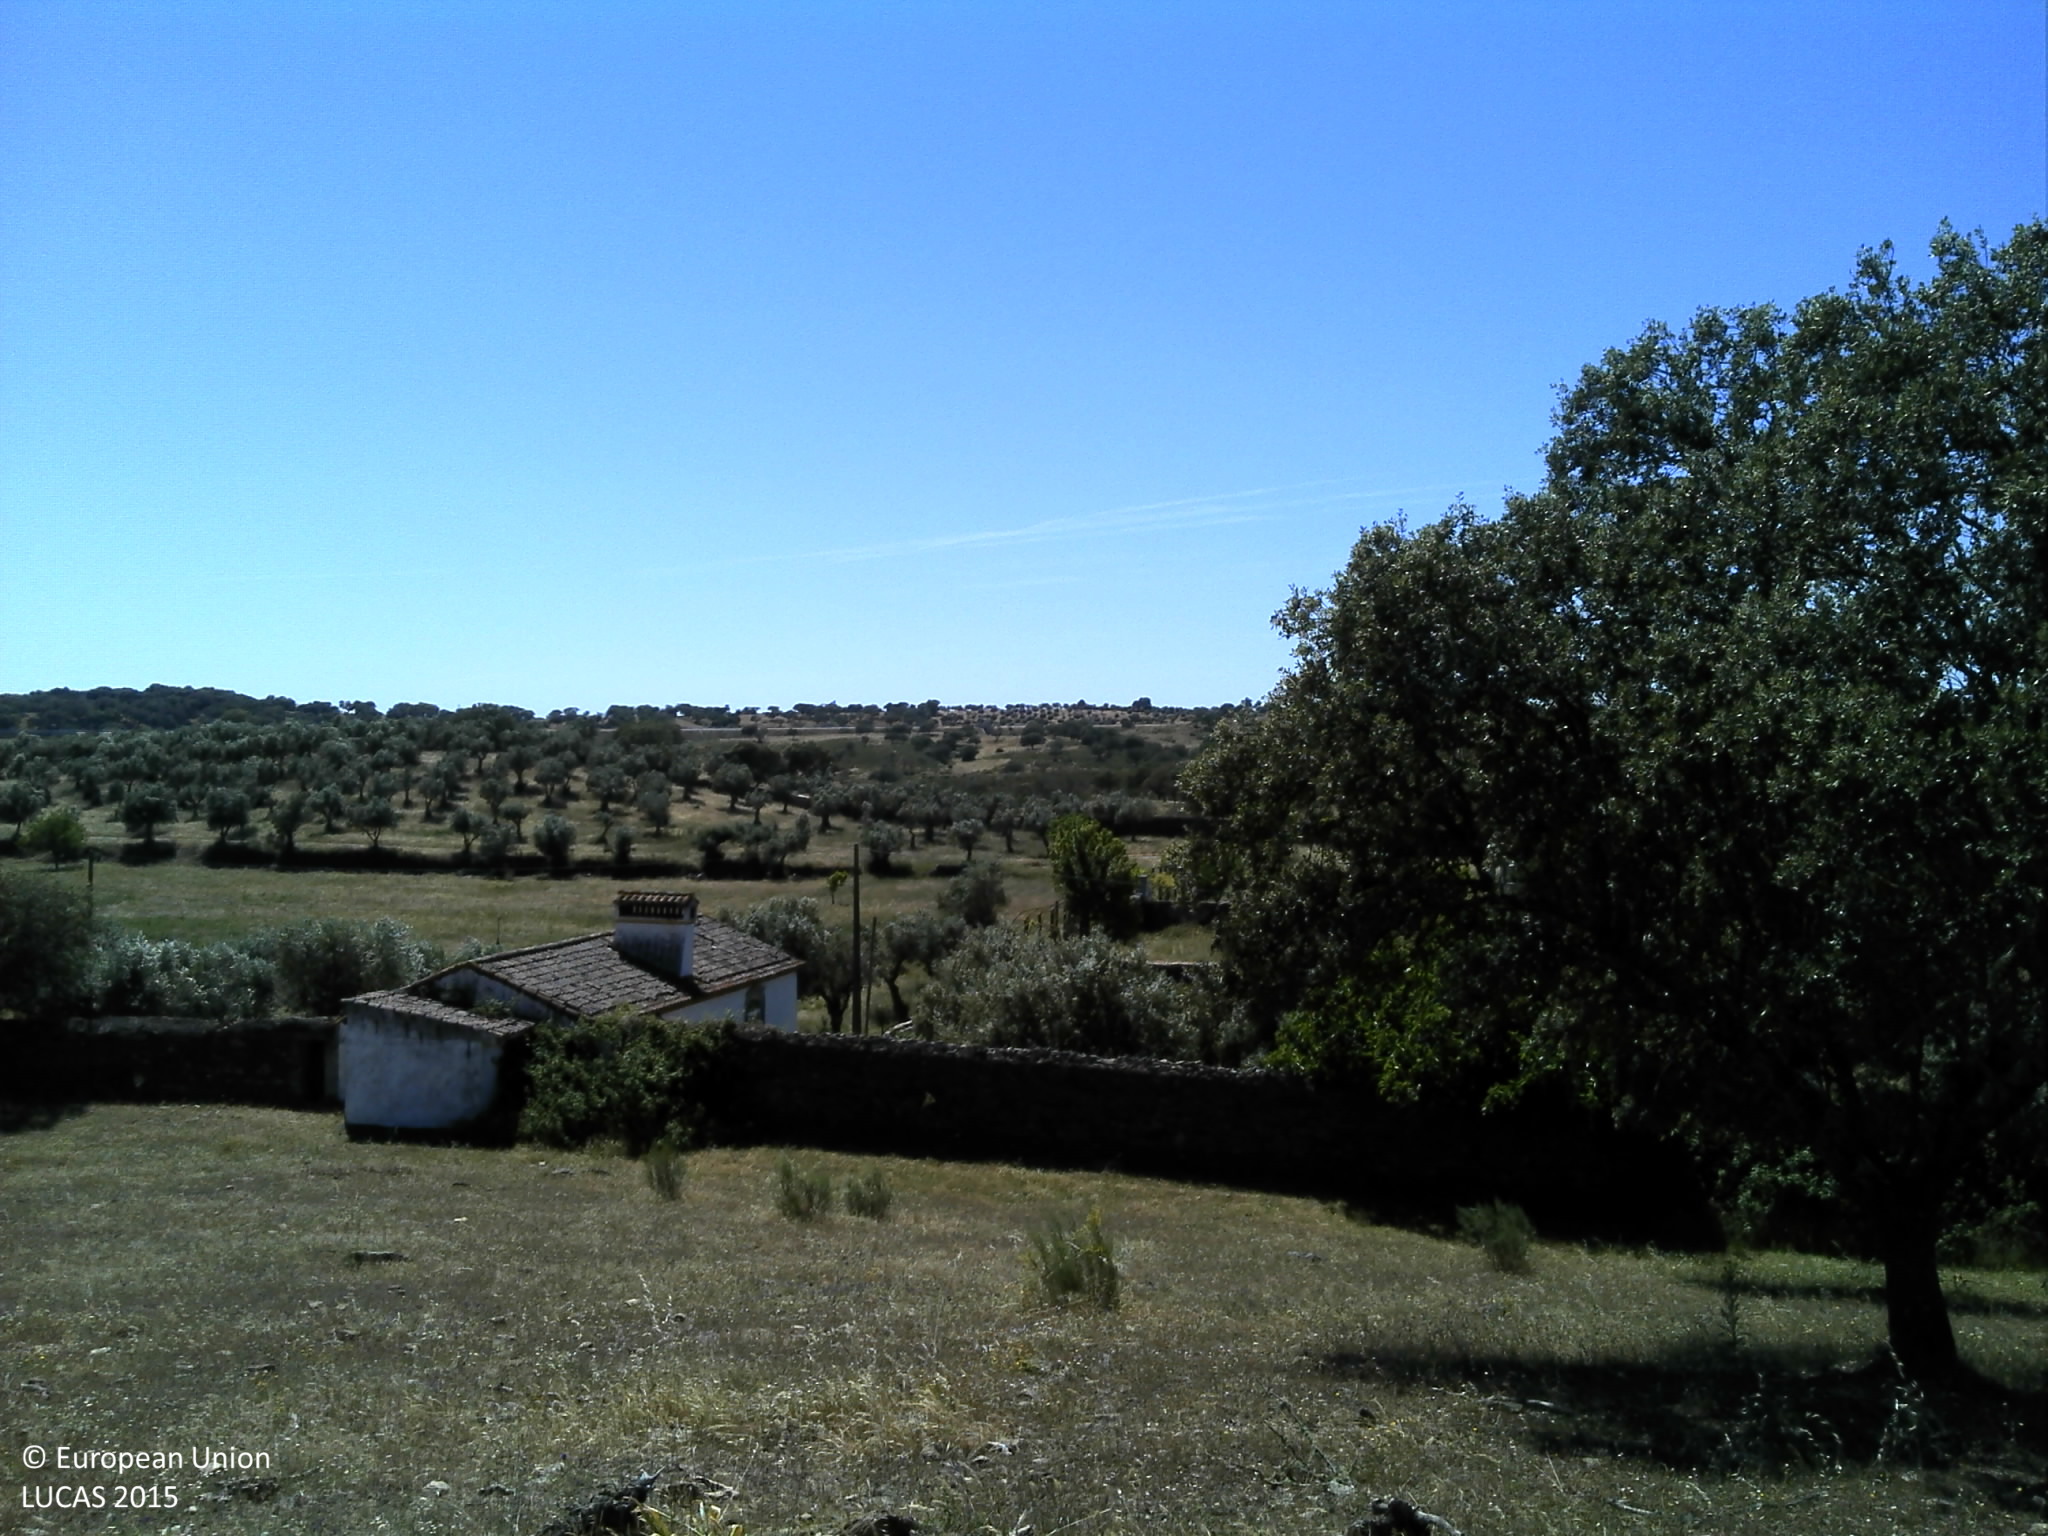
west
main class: Grassland
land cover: Grassland with sparse tree/shrub cover
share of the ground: 10 - 25 %
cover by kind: unconsolidated bare surface 70 %, herbaceous plants 25 %, broadleaved forest trees 5 %
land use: Agriculture (excluding fallow land and kitchen gardens)
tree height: > 5 m
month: May
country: PT
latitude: 39.2881
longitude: -7.6103
